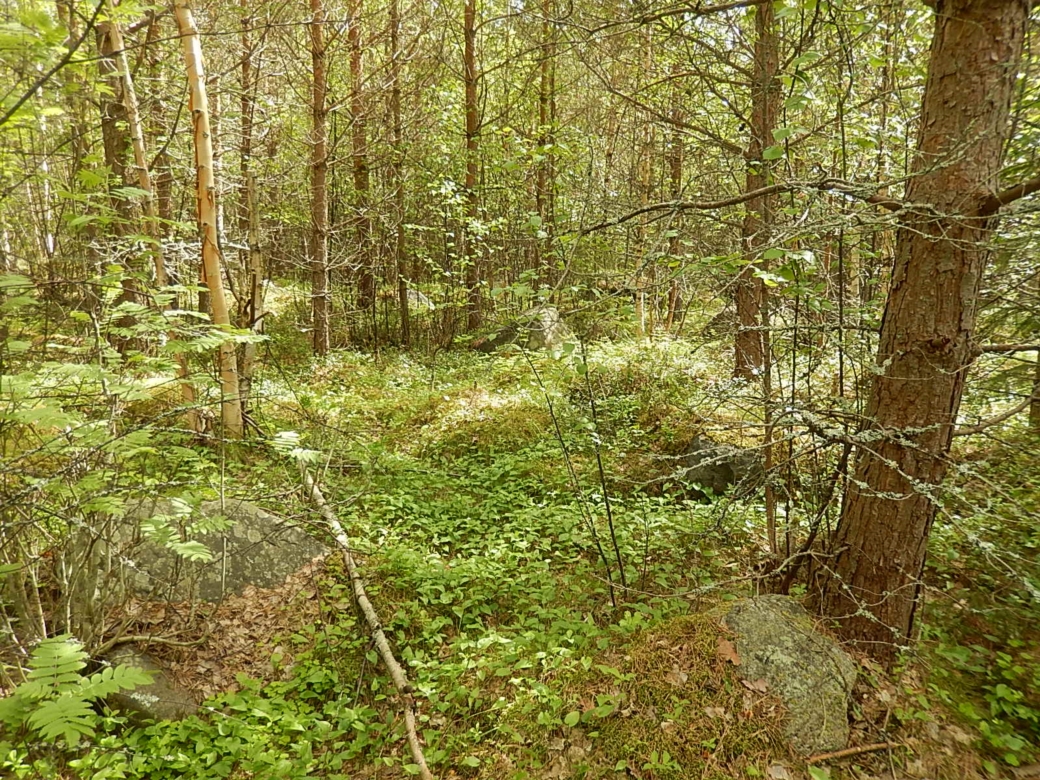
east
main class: Woodland
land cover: Pine dominated mixed woodland
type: boreal forest
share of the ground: > 75 %
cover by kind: coniferous forest trees 50 %, broadleaved forest trees 40 %, herbaceous plants 10 %
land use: Forestry
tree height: > 5 m
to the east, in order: Pine dominated mixed woodland; Inland marshes; Other coniferous woodland
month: June
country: FI
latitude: 61.8800
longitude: 21.4780
